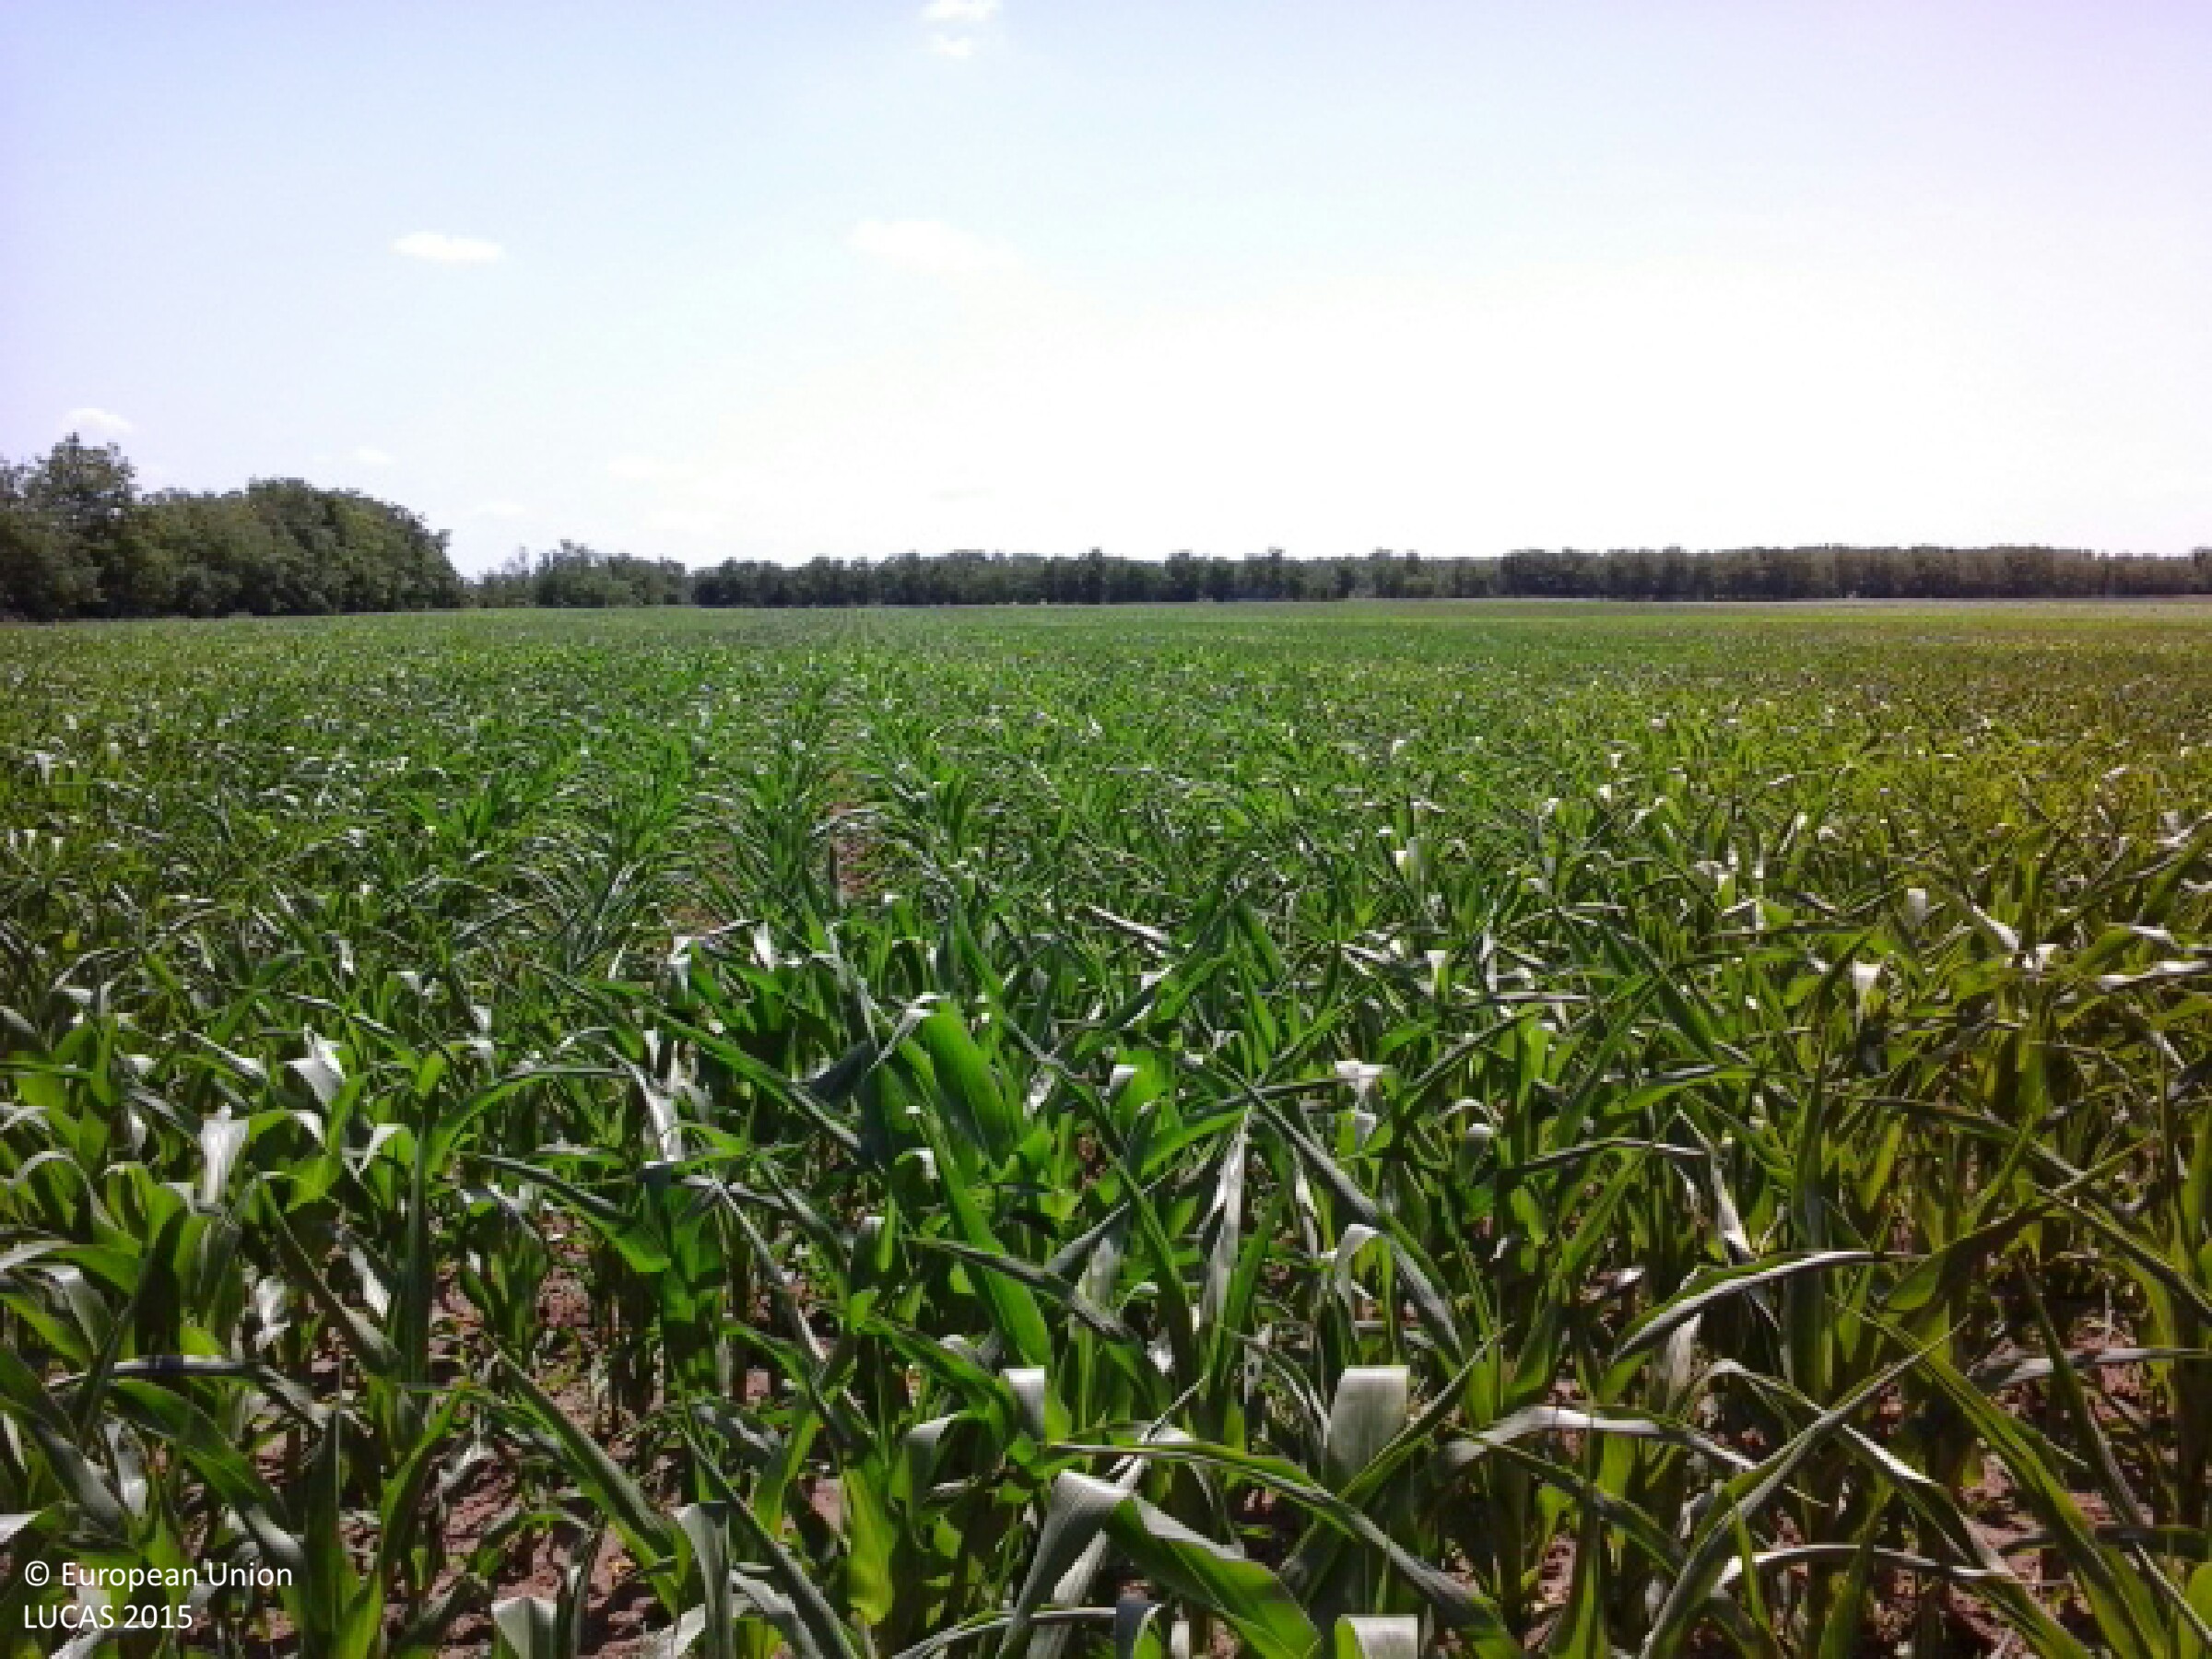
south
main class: Cropland
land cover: Maize
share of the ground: 50 - 75 %
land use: Agriculture (excluding fallow land and kitchen gardens)
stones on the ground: < 10 %
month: June
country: HU
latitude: 47.8539
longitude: 21.6879
